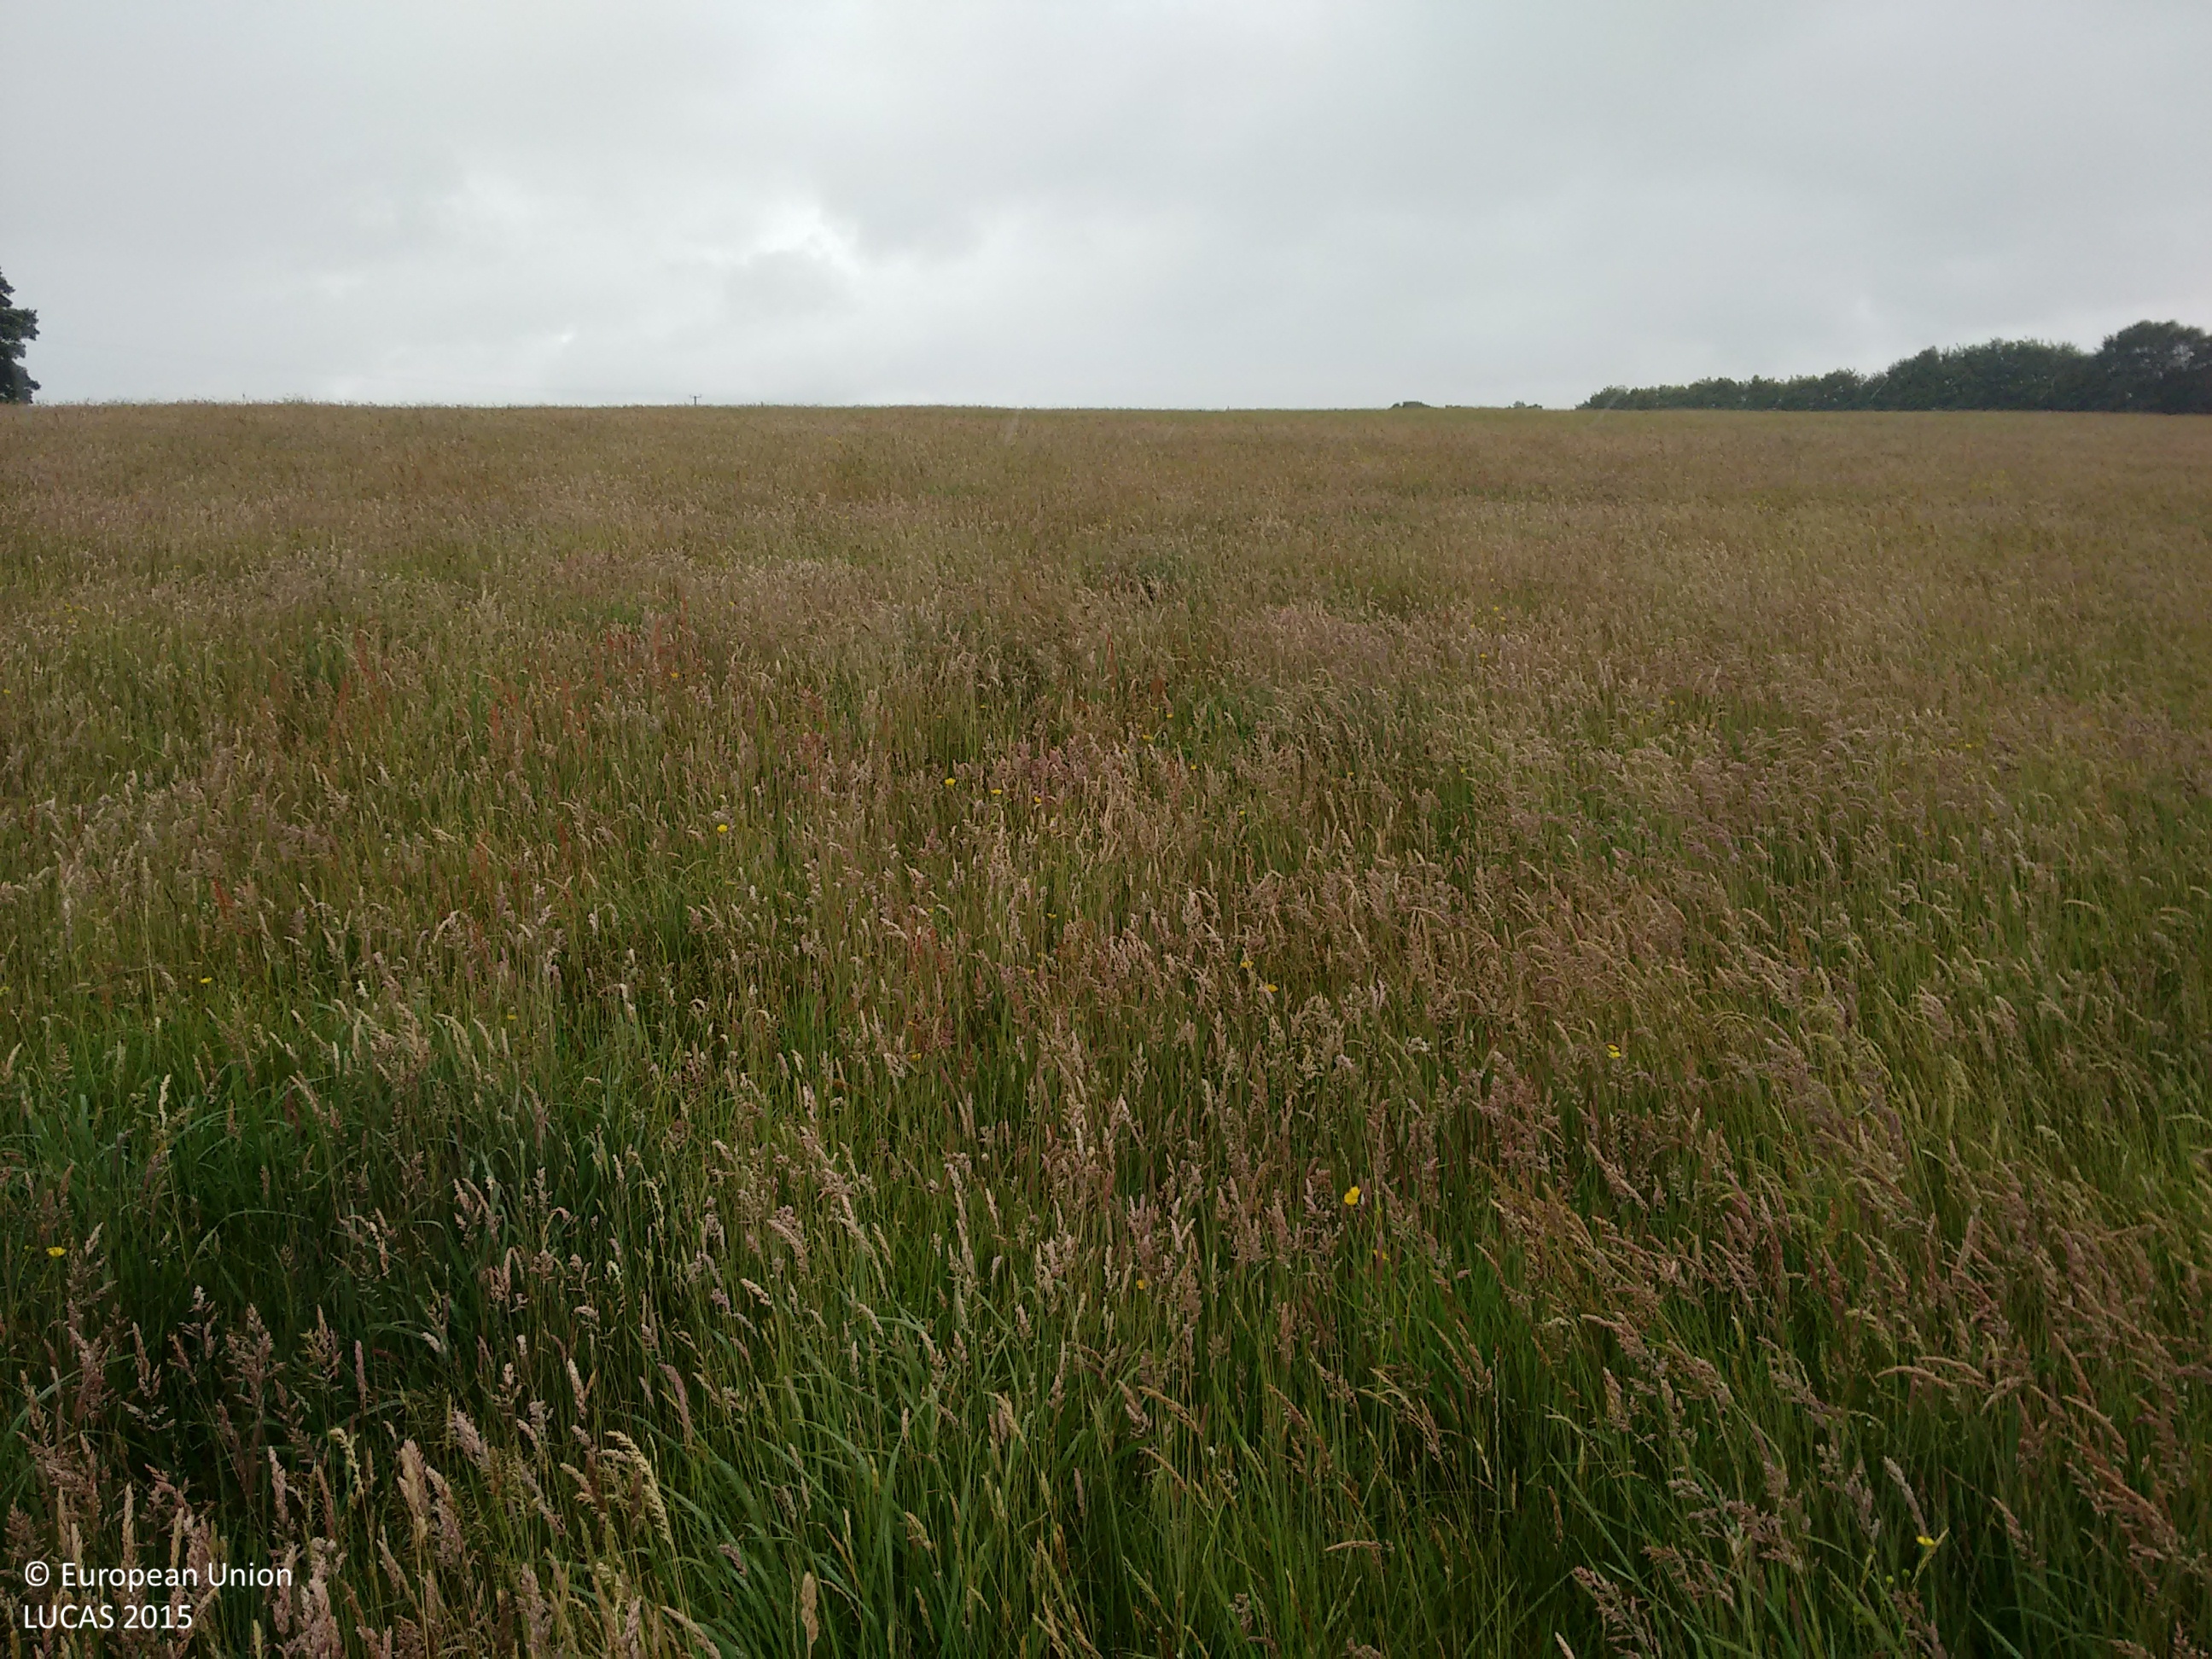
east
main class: Grassland
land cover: Grassland without tree/shrub cover
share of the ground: > 75 %
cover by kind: herbaceous plants 100 %
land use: Agriculture (excluding fallow land and kitchen gardens)
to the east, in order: Grassland without tree/shrub cover; Dry stone walls; Grassland without tree/shrub cover
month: July
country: GB
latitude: 53.1917
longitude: -1.7432
